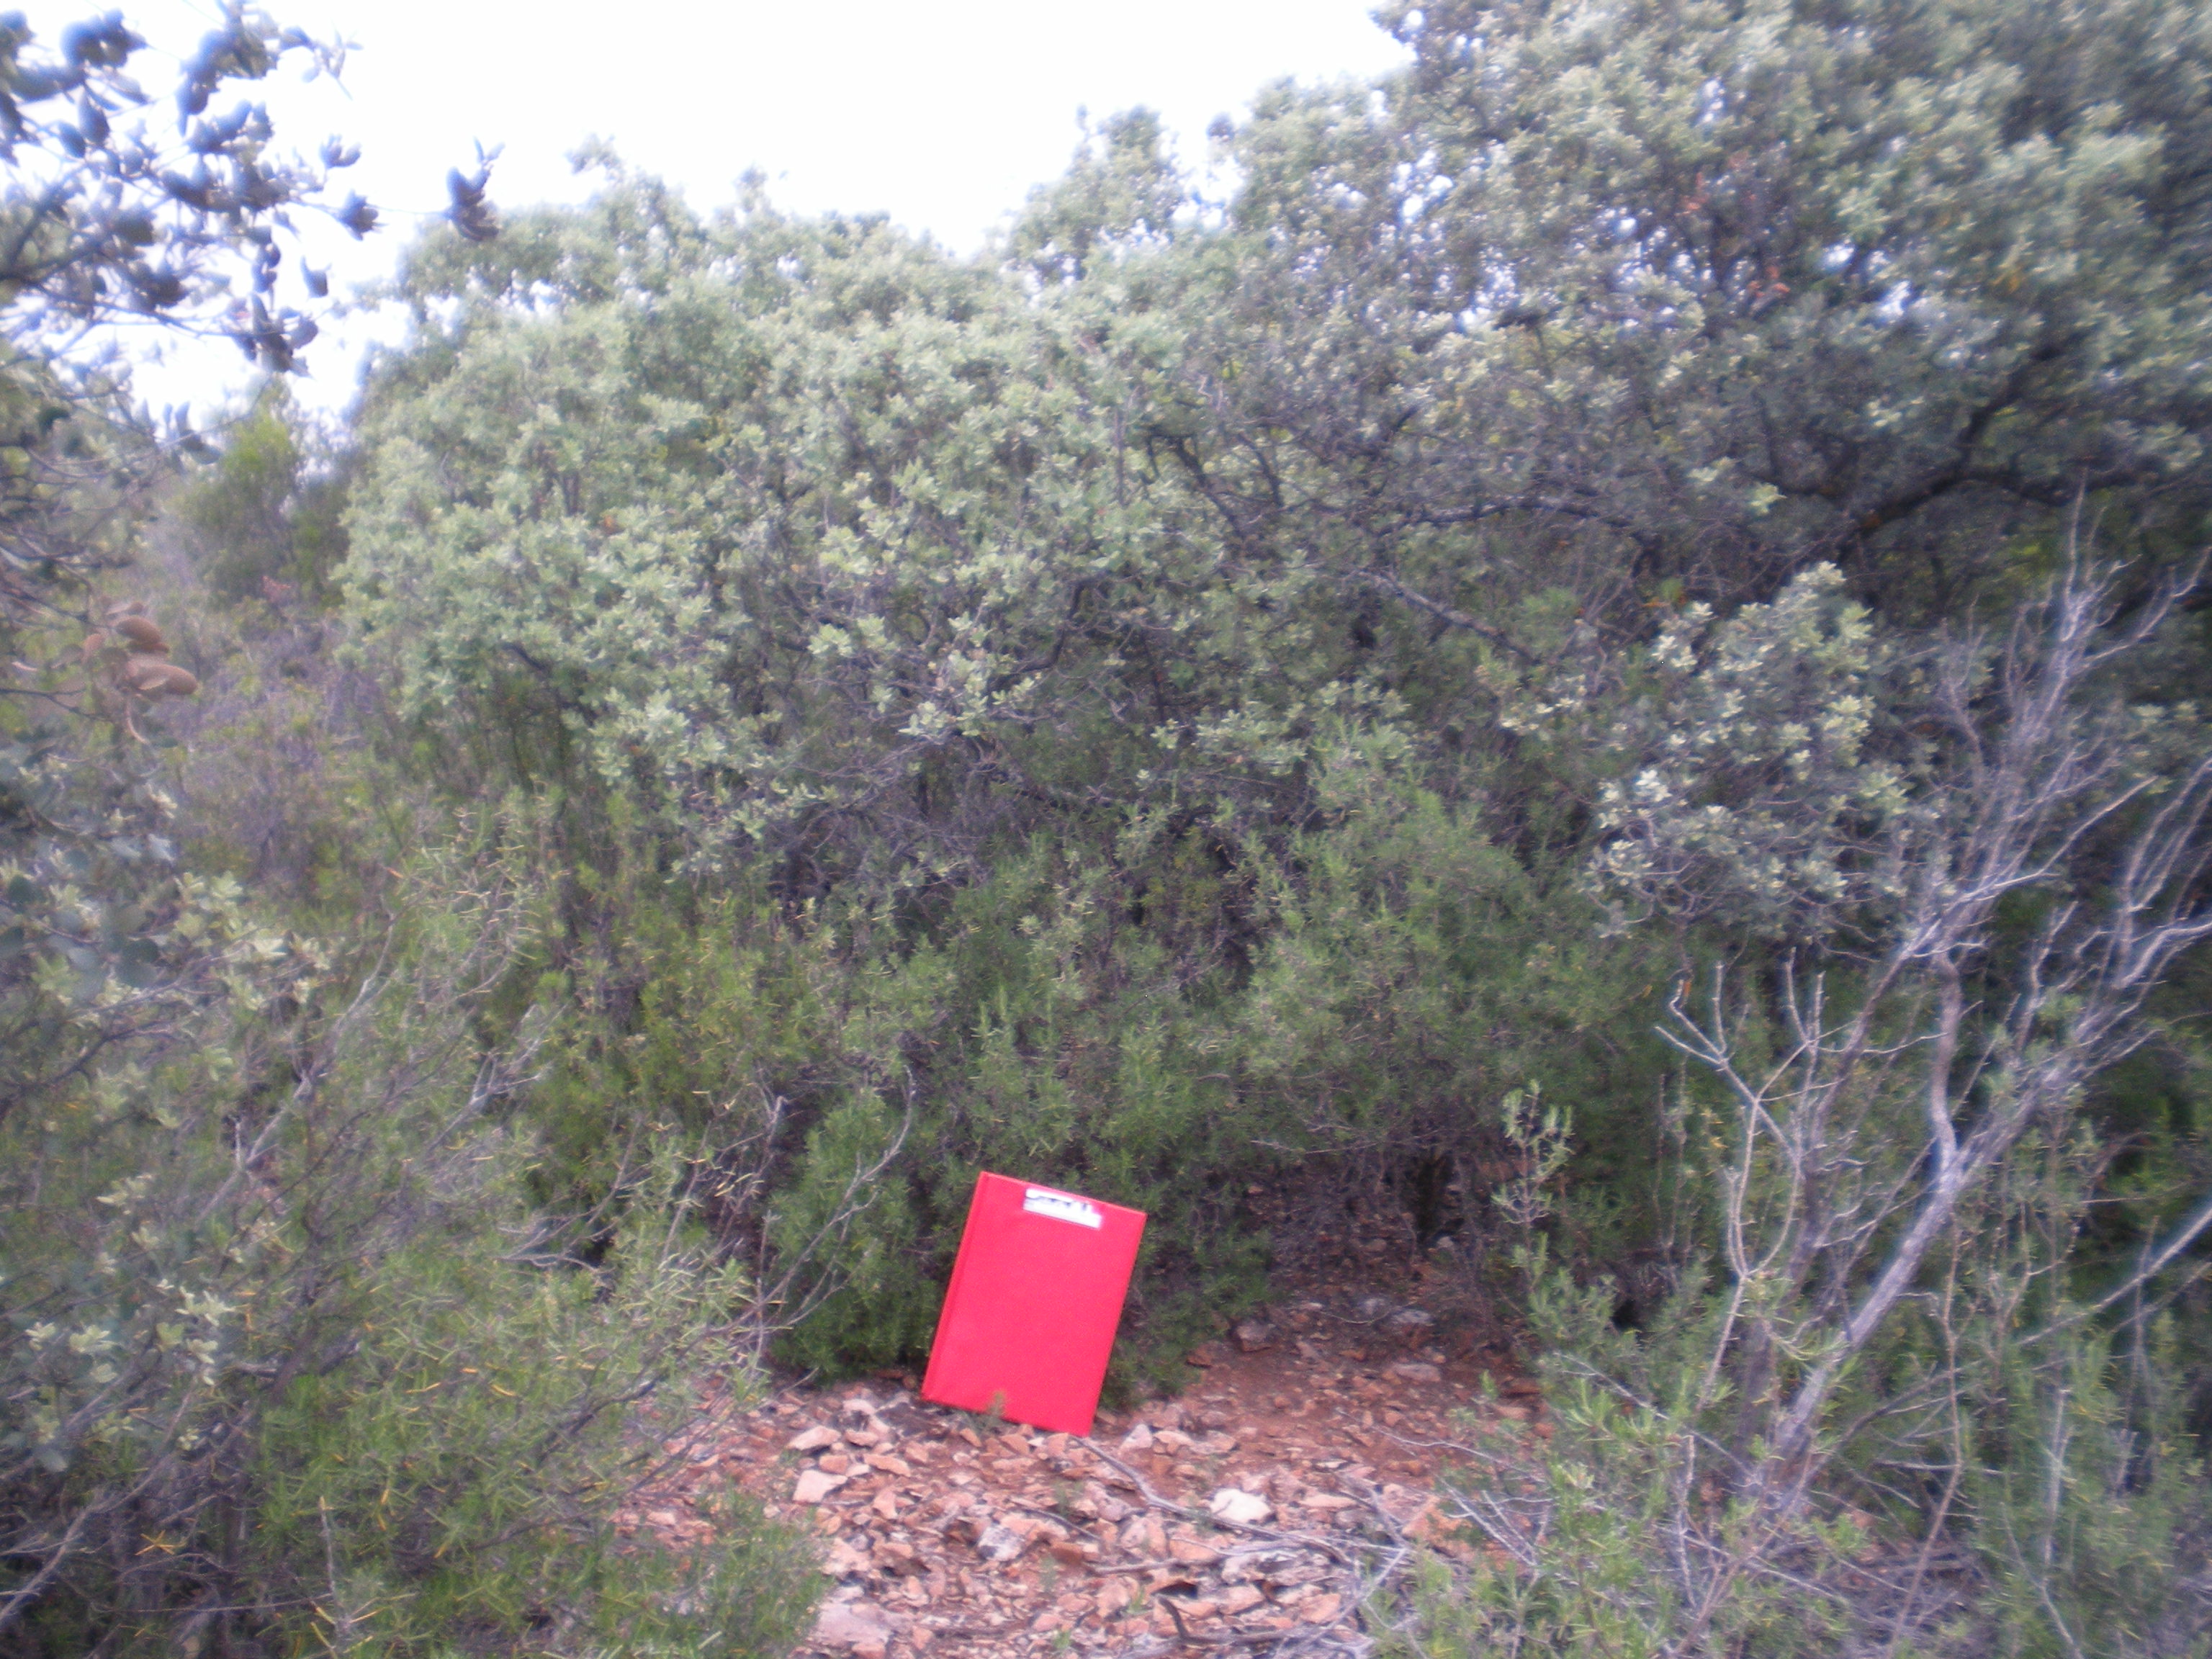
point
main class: Woodland
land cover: Broadleaved woodland
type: broadleaved evergreen forest
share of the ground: 50 - 75 %
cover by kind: broadleaved forest trees 40 %, shrubs 30 %, unconsolidated bare surface 20 %, herbaceous plants 10 %
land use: Other primary production
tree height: < 5 m
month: May
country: ES
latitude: 38.8352
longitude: -2.9678
